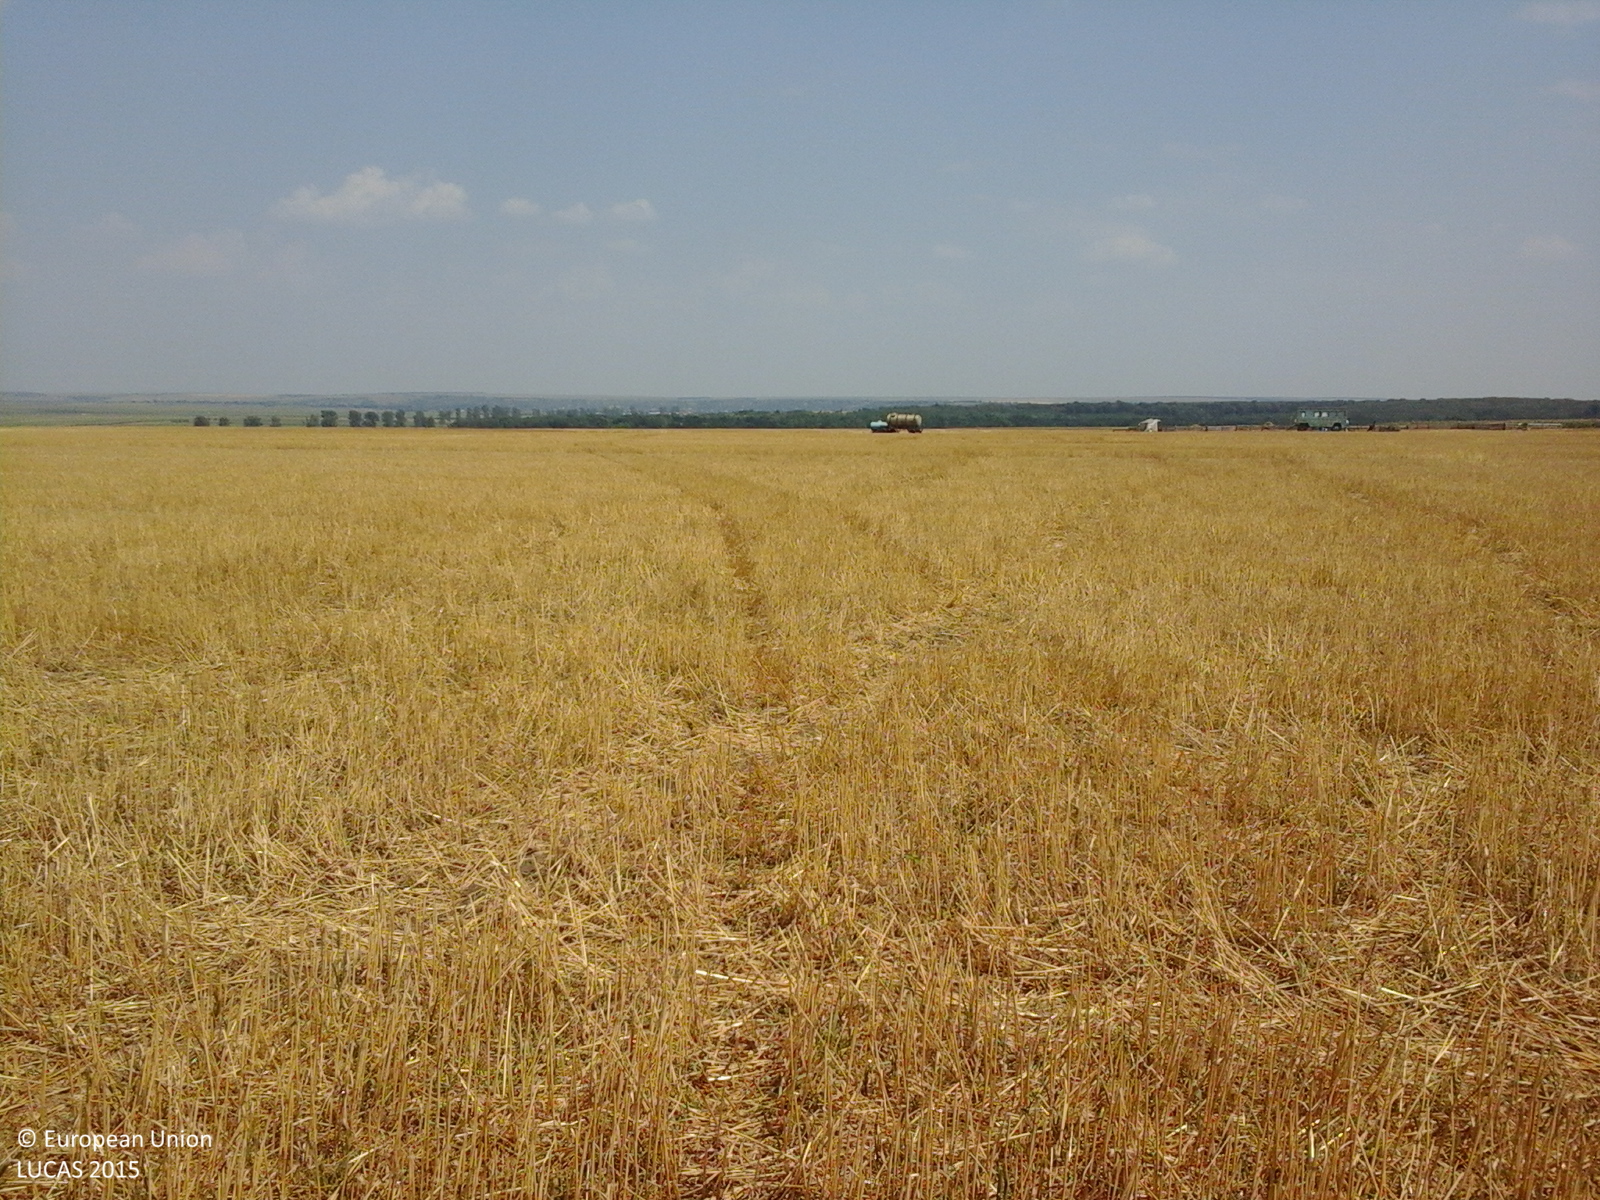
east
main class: Cropland
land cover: Common wheat
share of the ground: > 75 %
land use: Agriculture (excluding fallow land and kitchen gardens)
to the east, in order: Common wheat
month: July
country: RO
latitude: 45.8990
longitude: 27.5460
